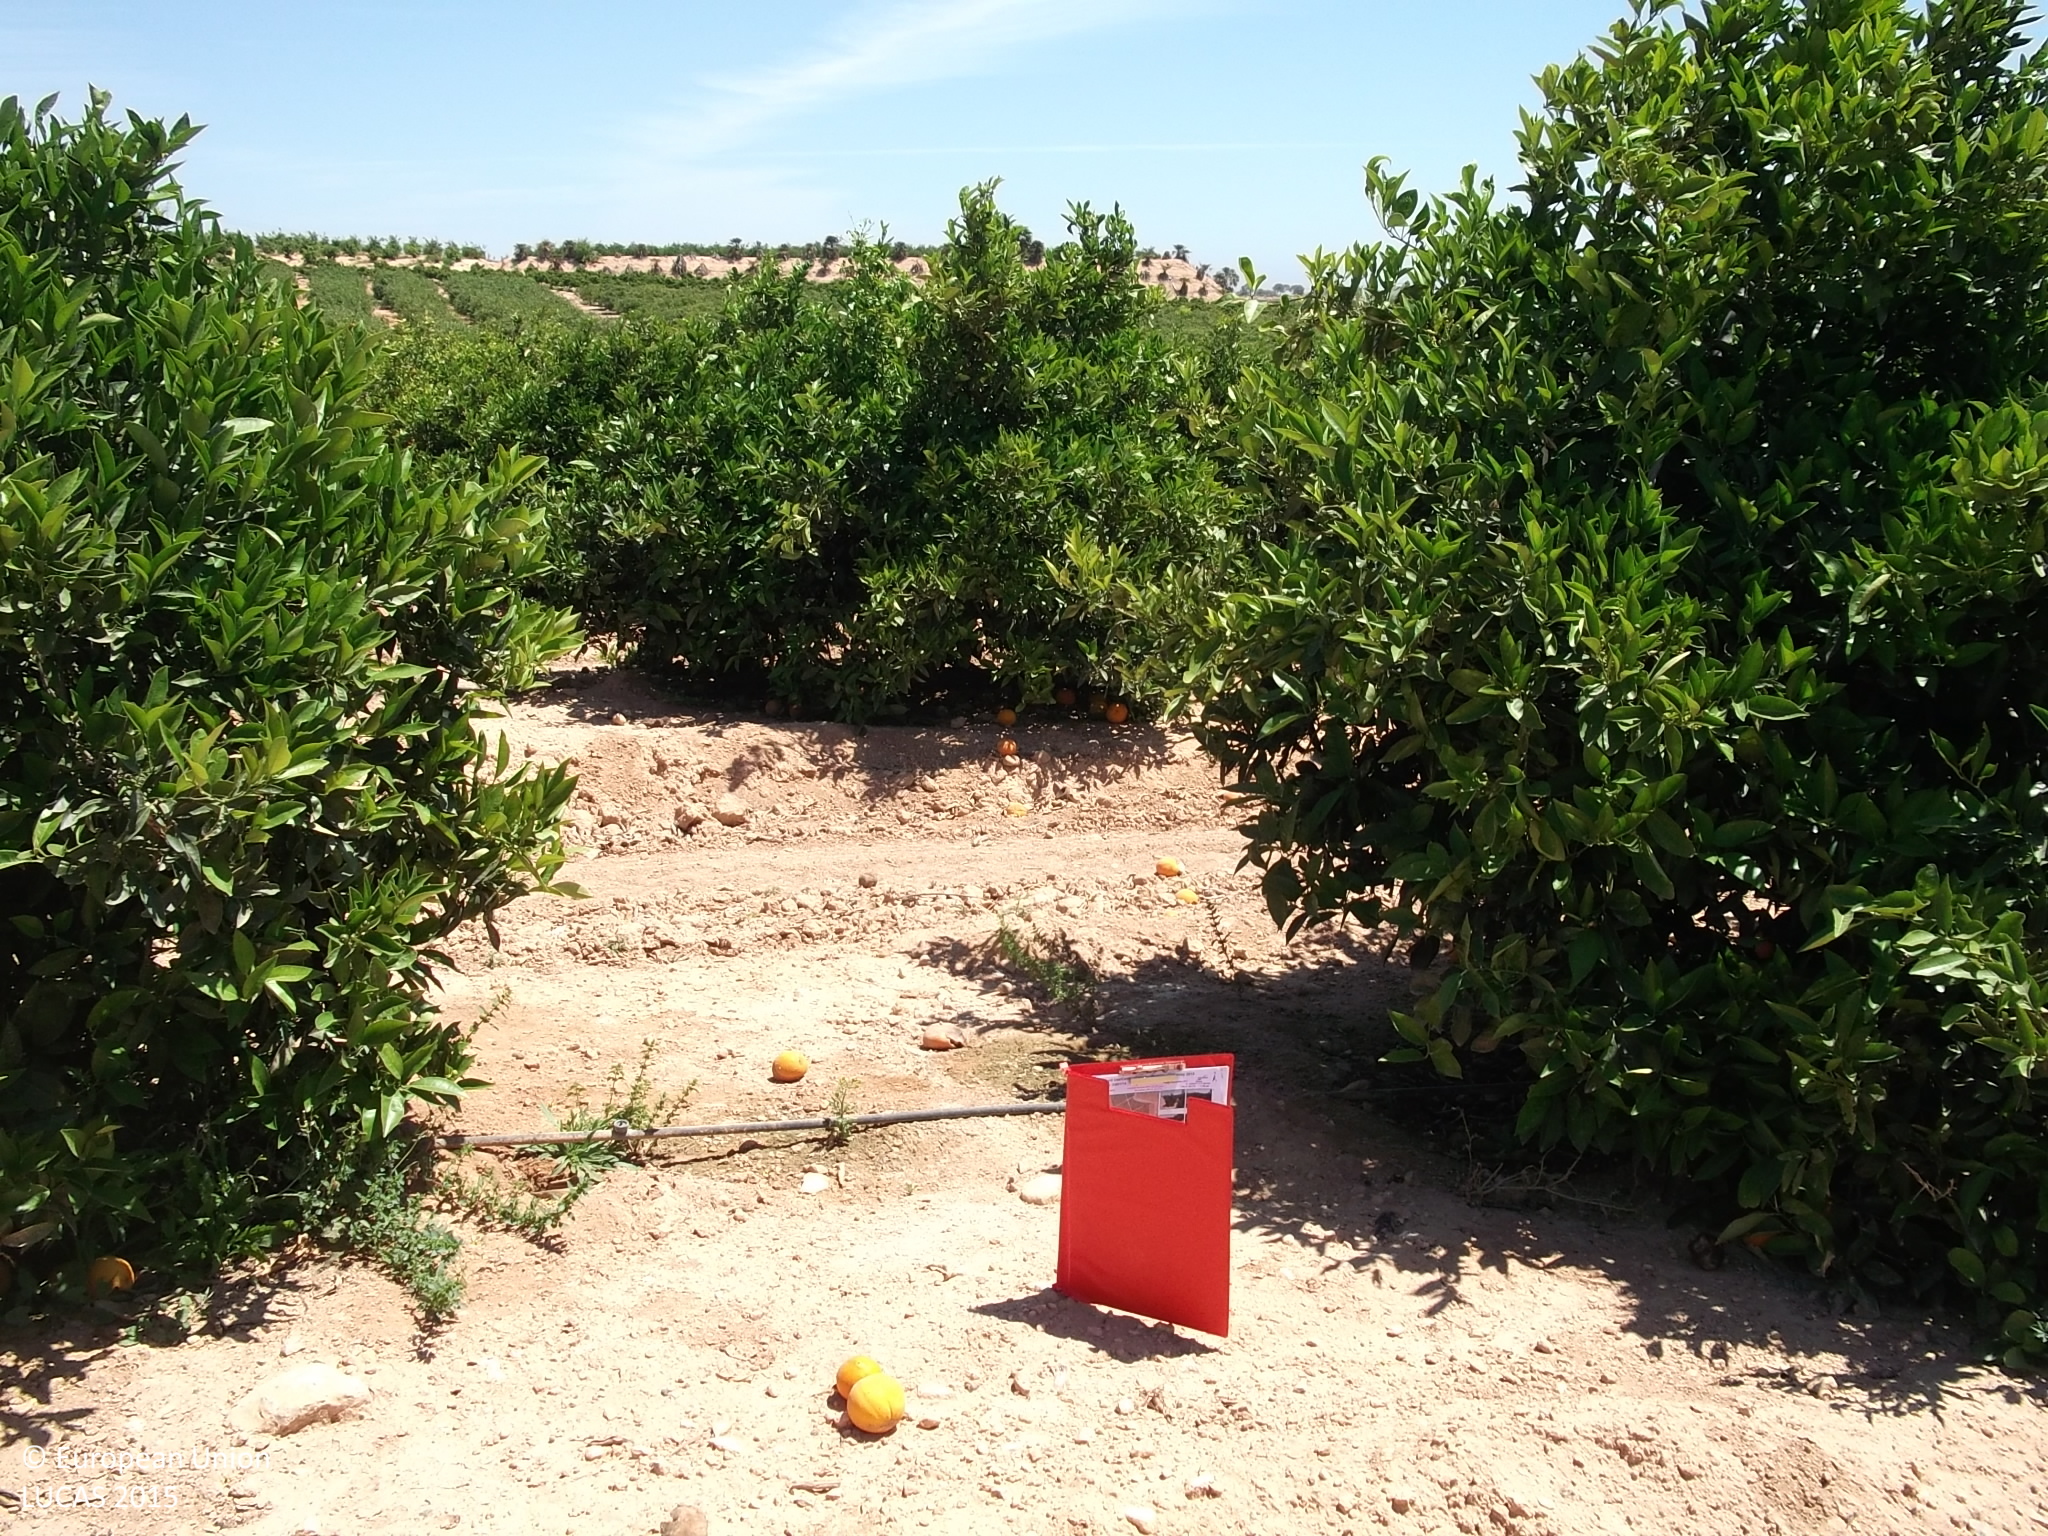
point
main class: Cropland
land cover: Oranges
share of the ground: 10 - 25 %
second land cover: Other bare soil
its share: > 75 %
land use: Agriculture (excluding fallow land and kitchen gardens)
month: May
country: ES
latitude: 37.8962
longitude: -0.8189
